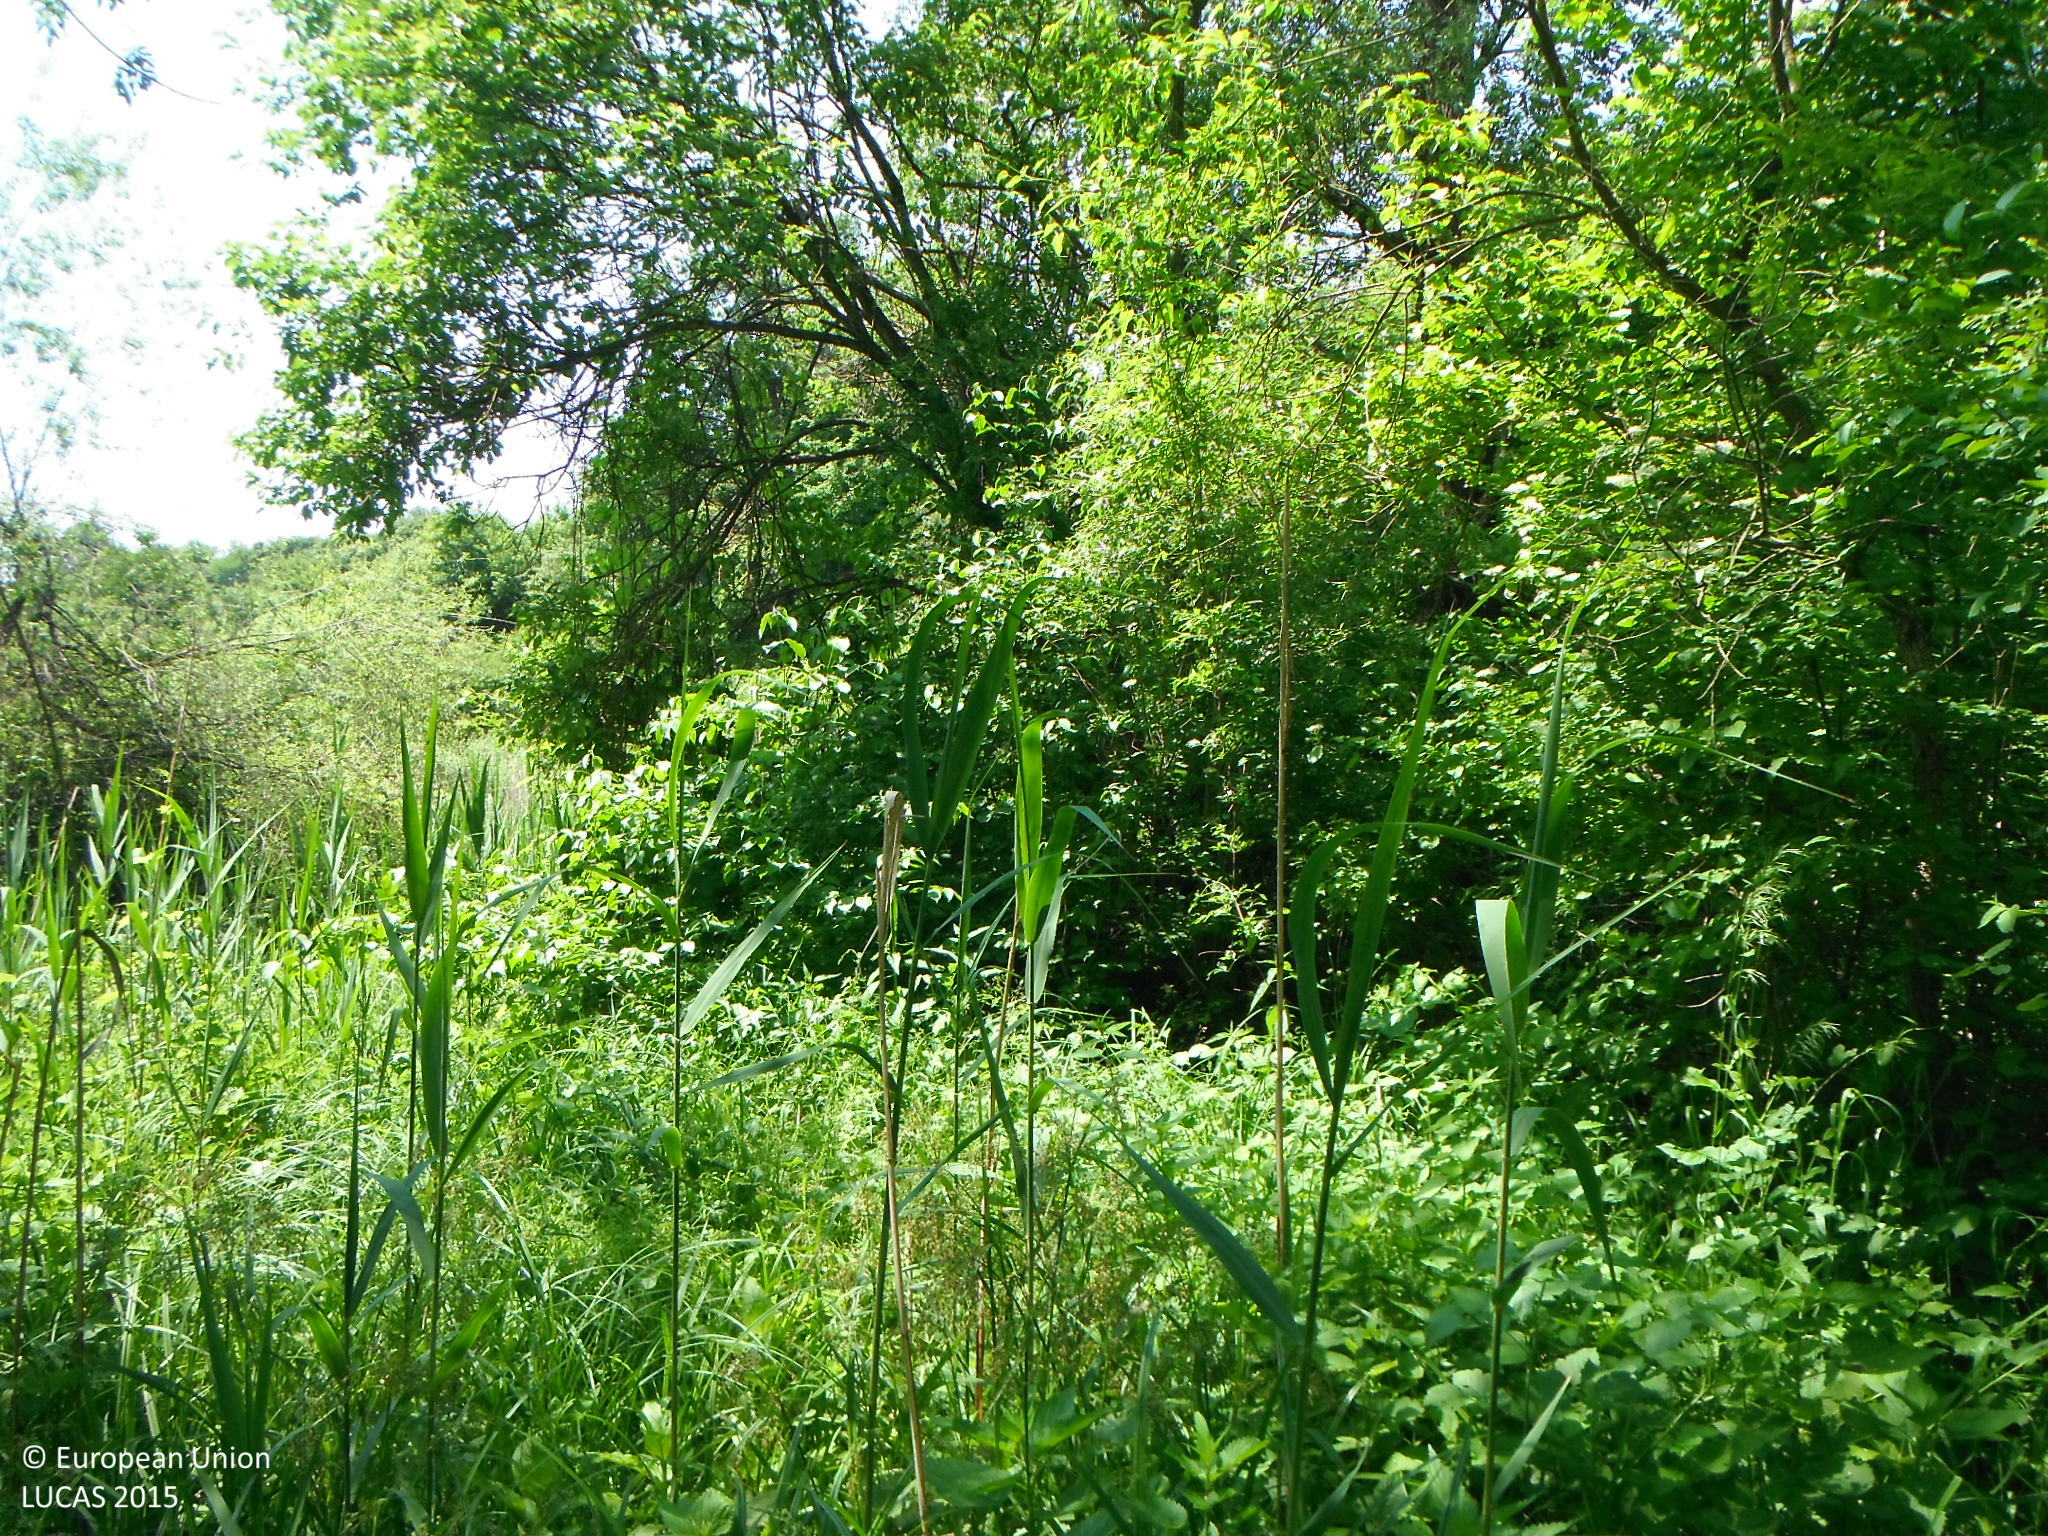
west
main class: Woodland
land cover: Broadleaved woodland
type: mire and swamp forests
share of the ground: > 75 %
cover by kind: broadleaved forest trees 85 %, shrubs 10 %, herbaceous plants 5 %
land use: Semi-natural and natural areas not in use
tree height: > 5 m
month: June
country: SK
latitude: 48.6876
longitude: 19.2191
